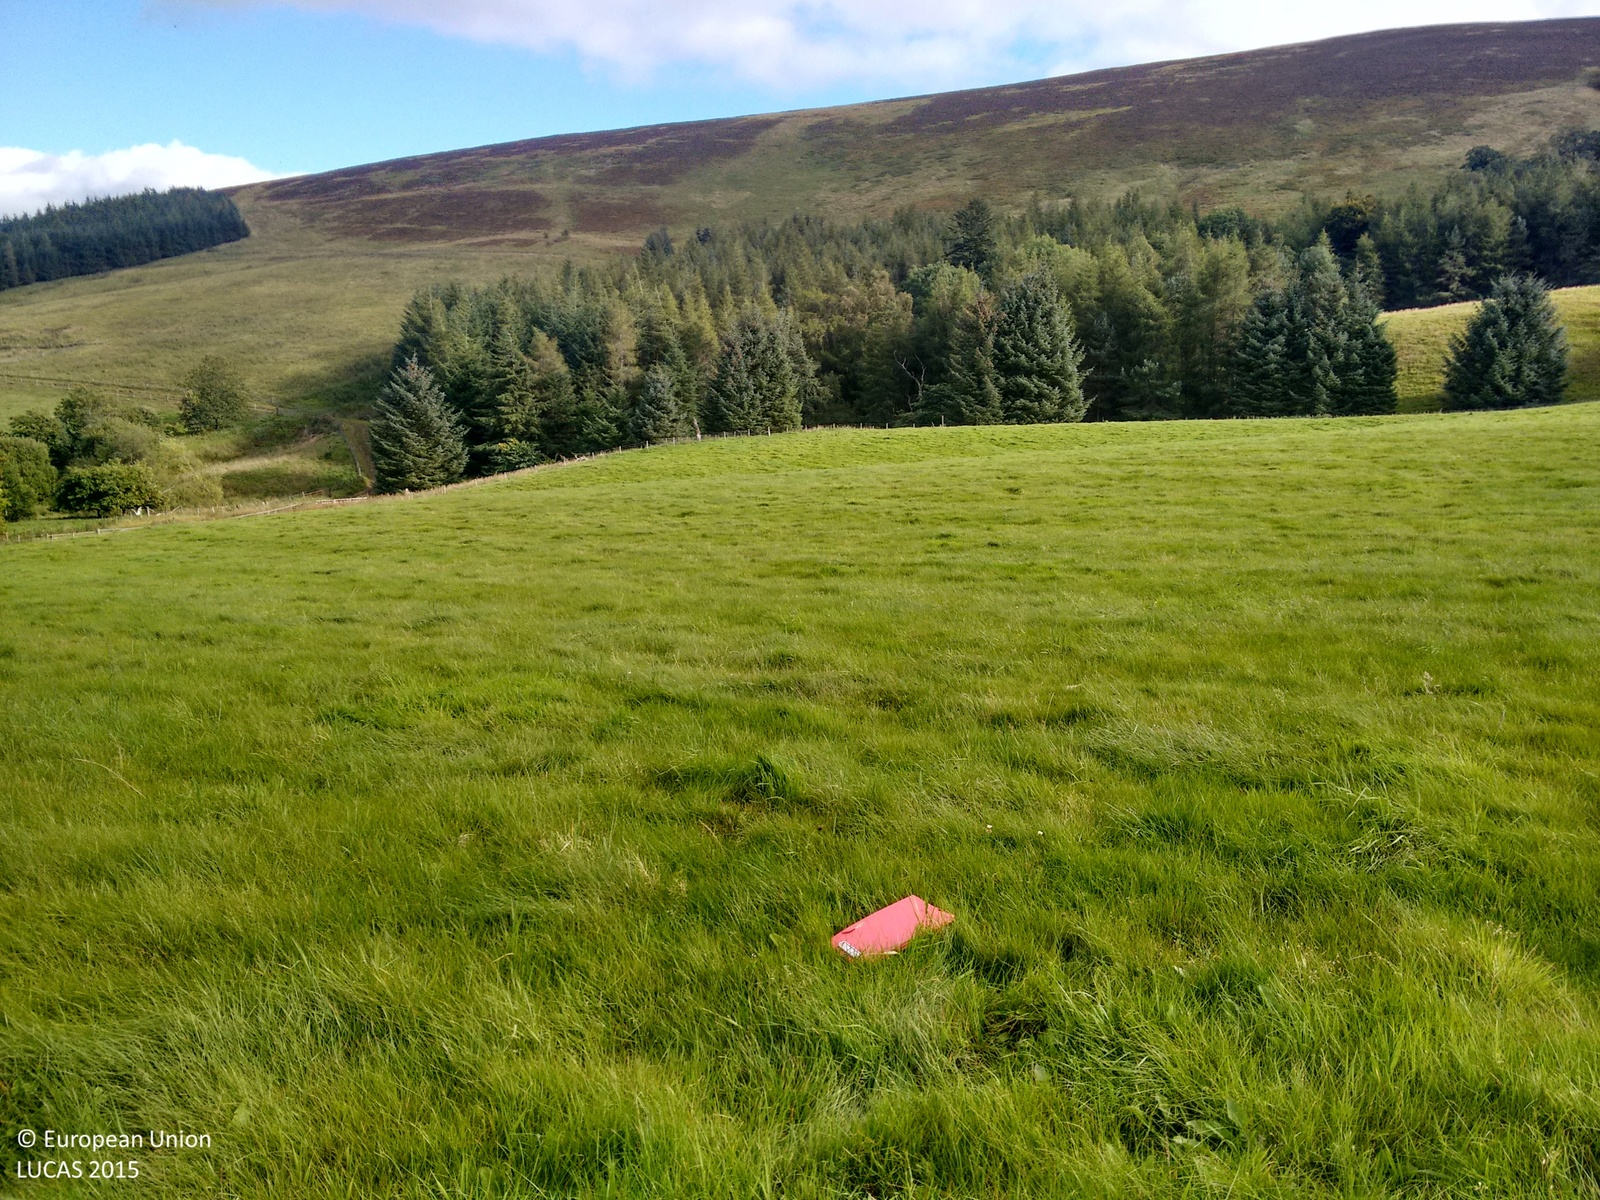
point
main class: Grassland
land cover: Grassland without tree/shrub cover
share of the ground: > 75 %
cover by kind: herbaceous plants 100 %
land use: Agriculture (excluding fallow land and kitchen gardens)
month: September
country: GB
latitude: 55.5712
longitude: -3.5766
